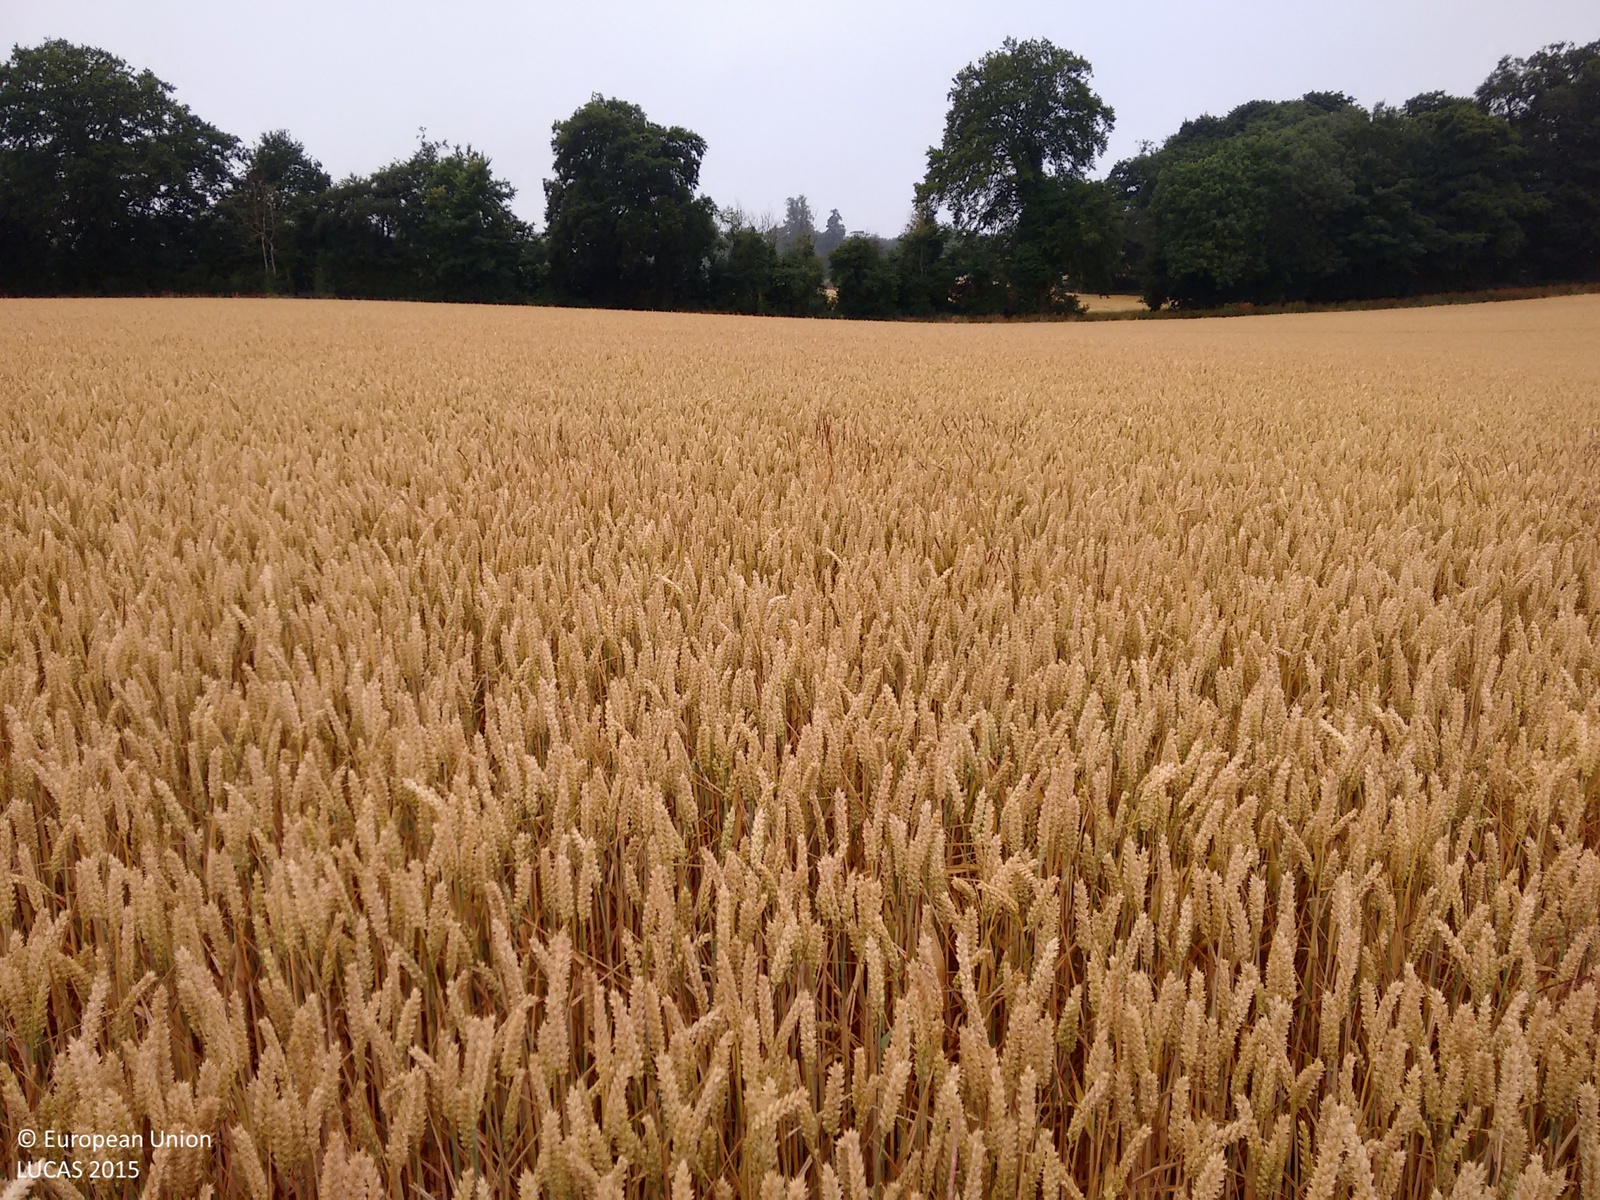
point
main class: Cropland
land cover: Common wheat
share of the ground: > 75 %
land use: Agriculture (excluding fallow land and kitchen gardens)
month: July
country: GB
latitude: 51.1797
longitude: -1.5097
